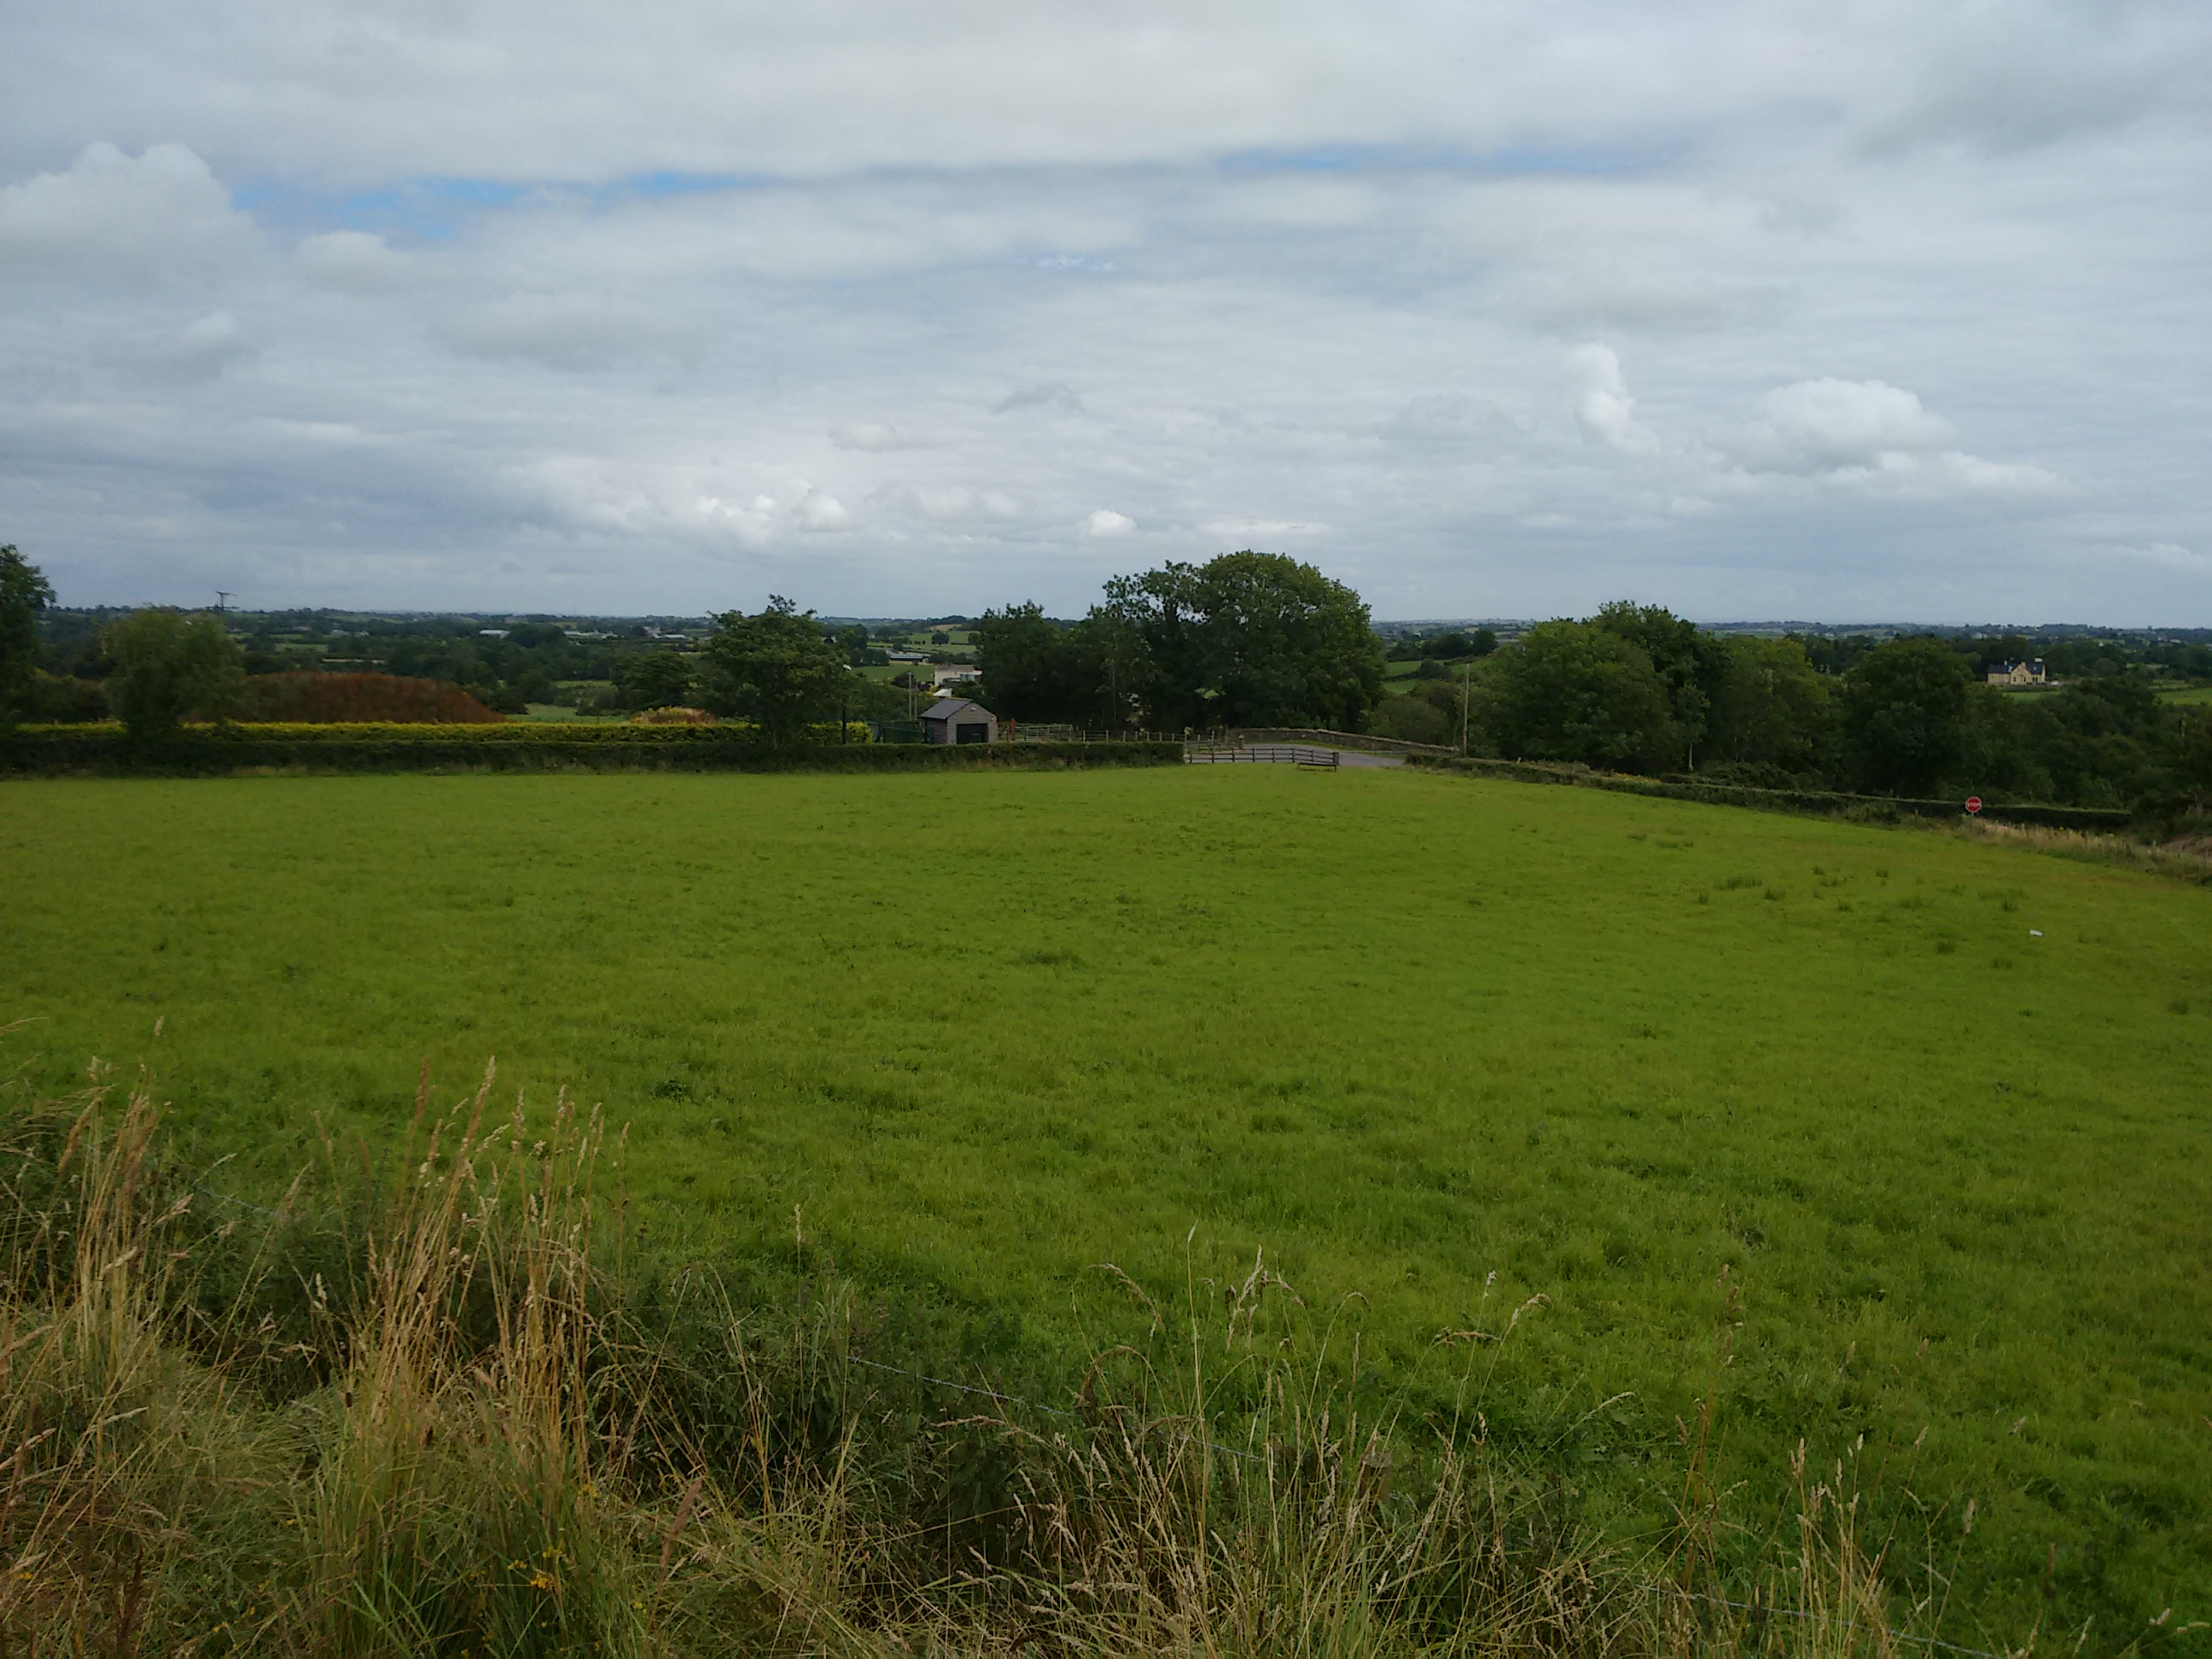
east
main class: Grassland
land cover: Grassland without tree/shrub cover
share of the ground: > 75 %
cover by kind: herbaceous plants 100 %
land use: Agriculture (excluding fallow land and kitchen gardens)
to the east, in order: Grassland without tree/shrub cover; Fences; Grassland without tree/shrub cover; Fences; Managed hedges; Electric lines; Grass margins; Paved roads, cycling and walking lanes; Grass margins; Managed hedges; Fences; Grassland without tree/shrub cover; Fences; Abandoned hedges; Grassland without tree/shrub cover; Broadleaved woodland; Grassland without tree/shrub cover; Broadleaved woodland
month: August
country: GB
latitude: 54.5593
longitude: -6.8830
